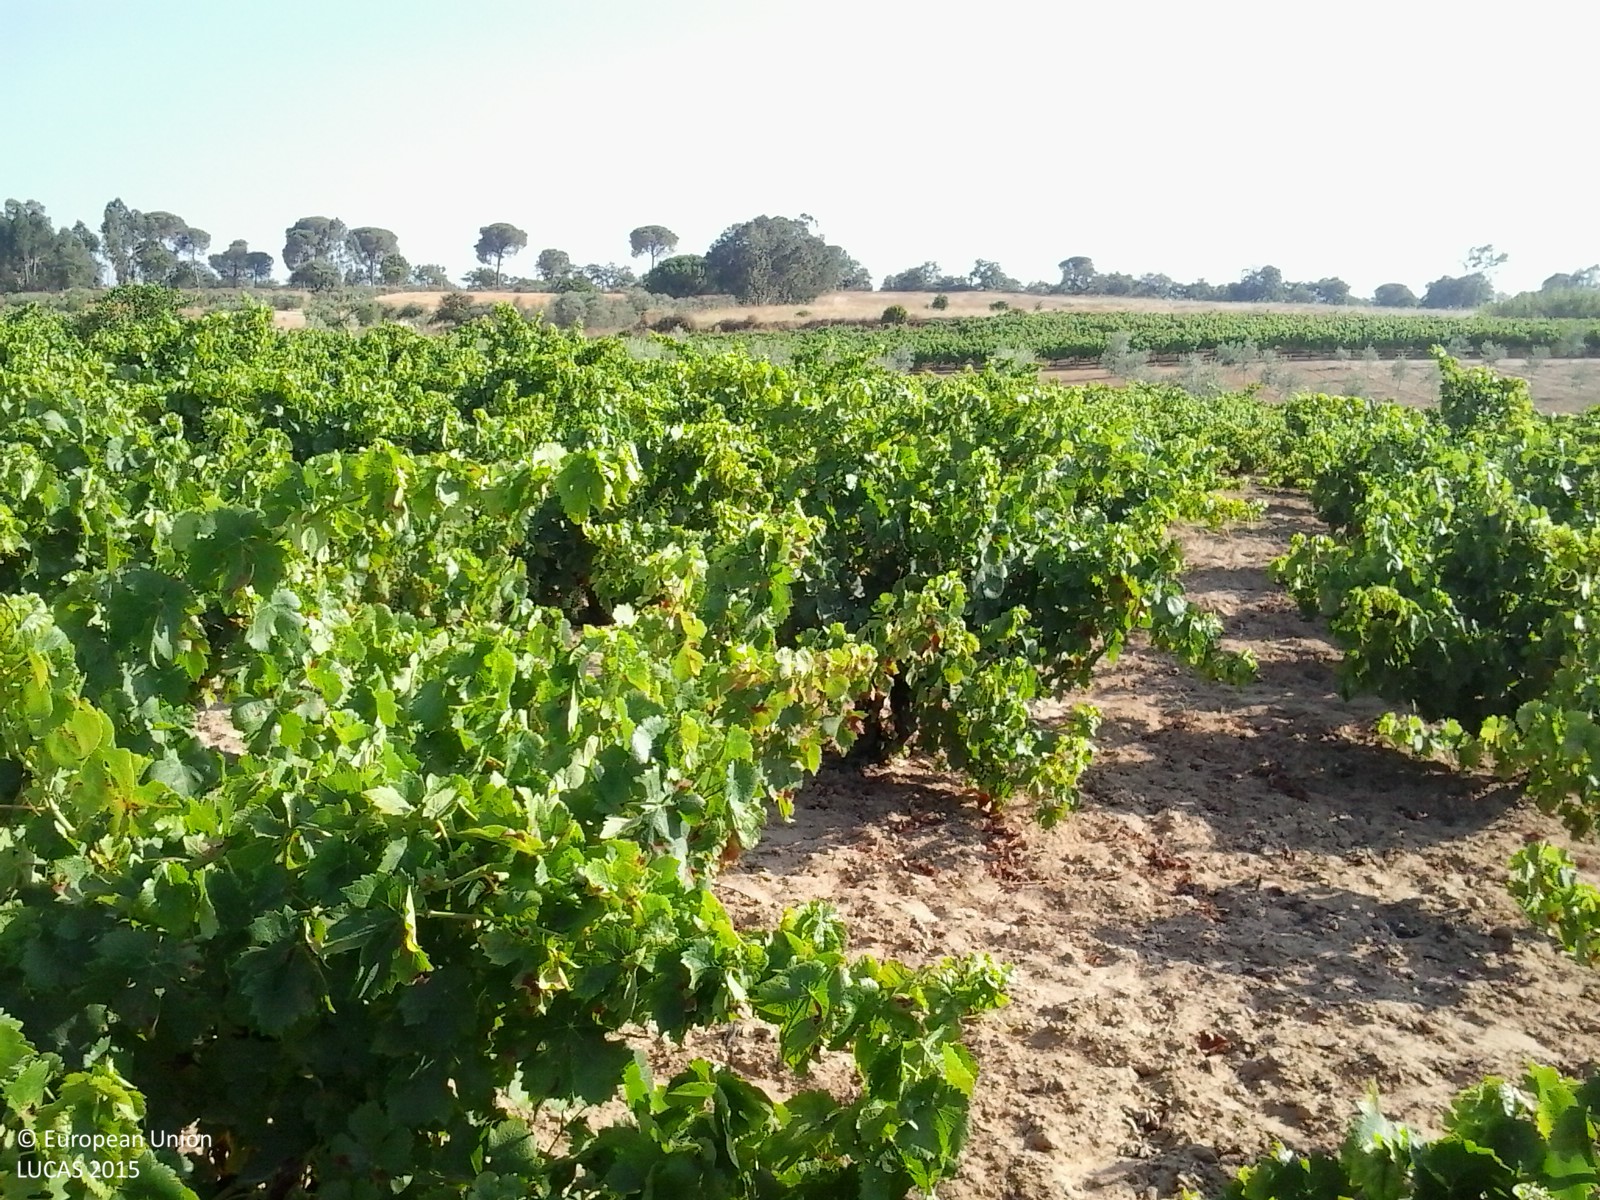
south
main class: Cropland
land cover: Vineyards
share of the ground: 10 - 25 %
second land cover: Other bare soil
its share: > 75 %
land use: Agriculture (excluding fallow land and kitchen gardens)
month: June
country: ES
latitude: 37.3727
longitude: -6.4619
